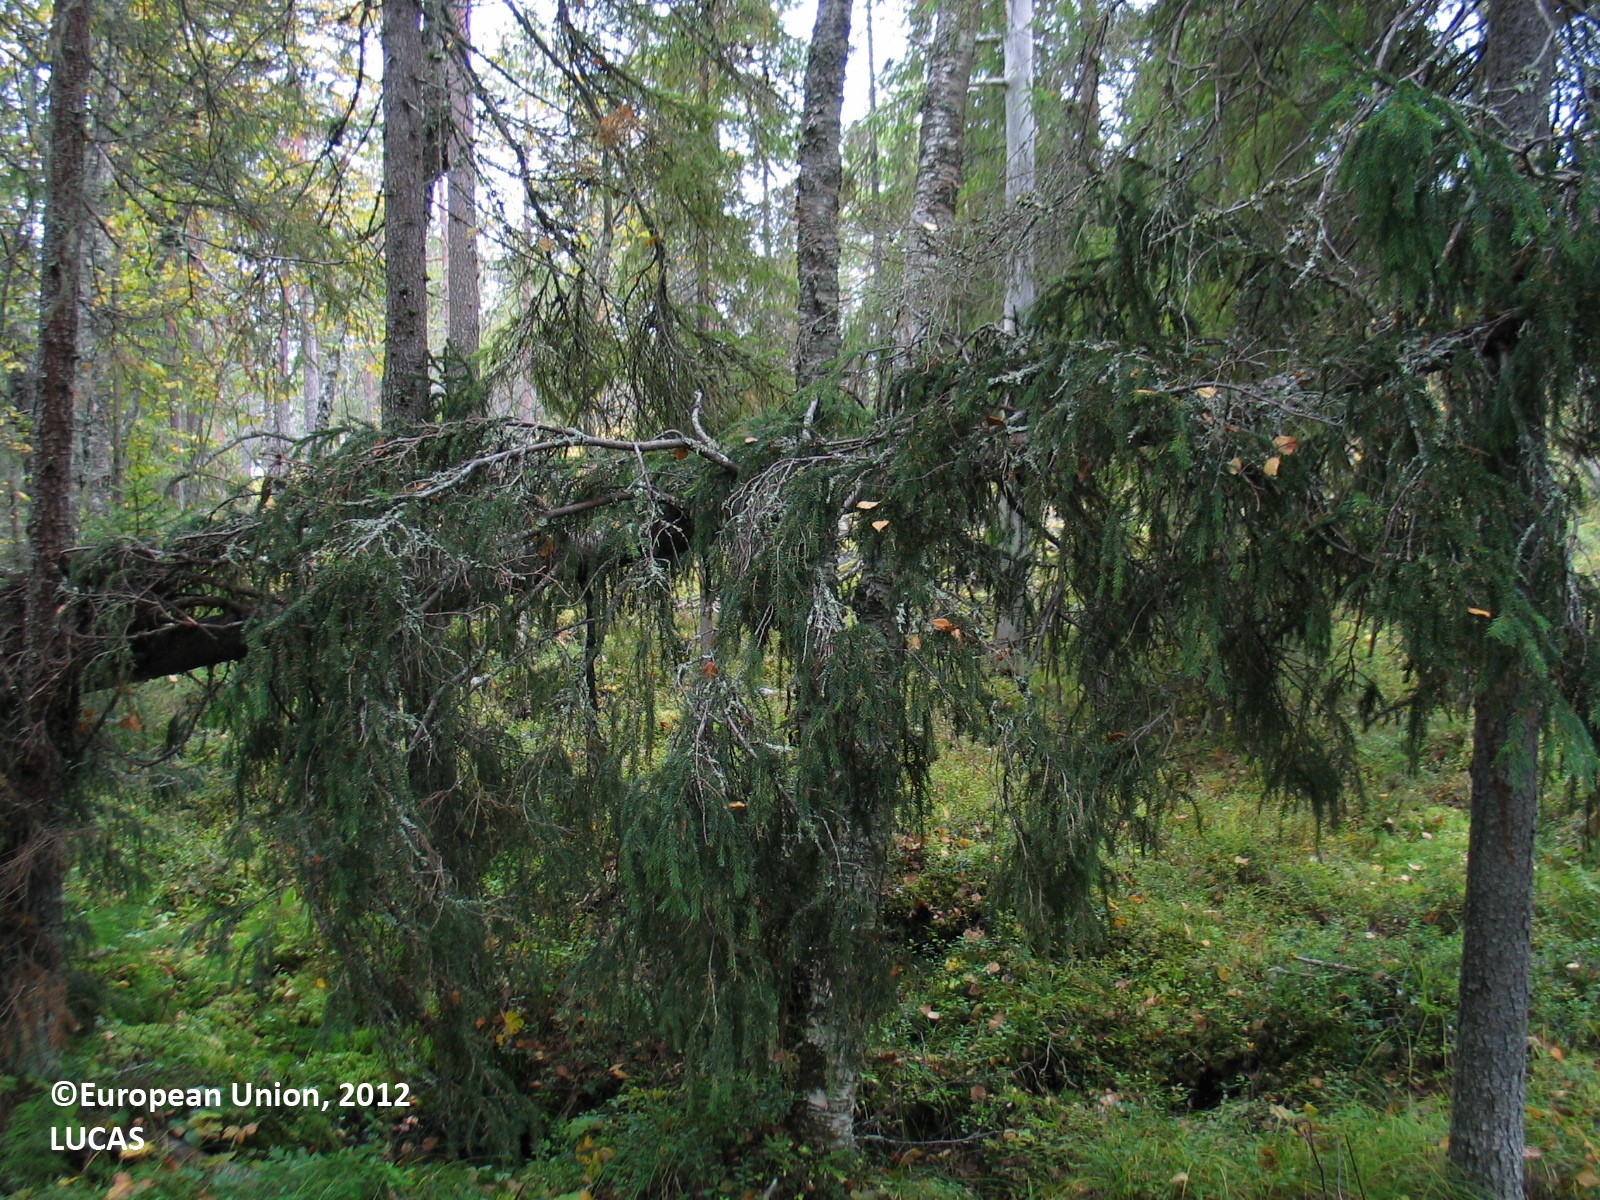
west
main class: Woodland
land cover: Spruce dominated mixed woodland
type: mire and swamp forests
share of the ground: 50 - 75 %
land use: Forestry
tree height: > 5 m
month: September
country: FI
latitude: 65.6092
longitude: 25.1071
